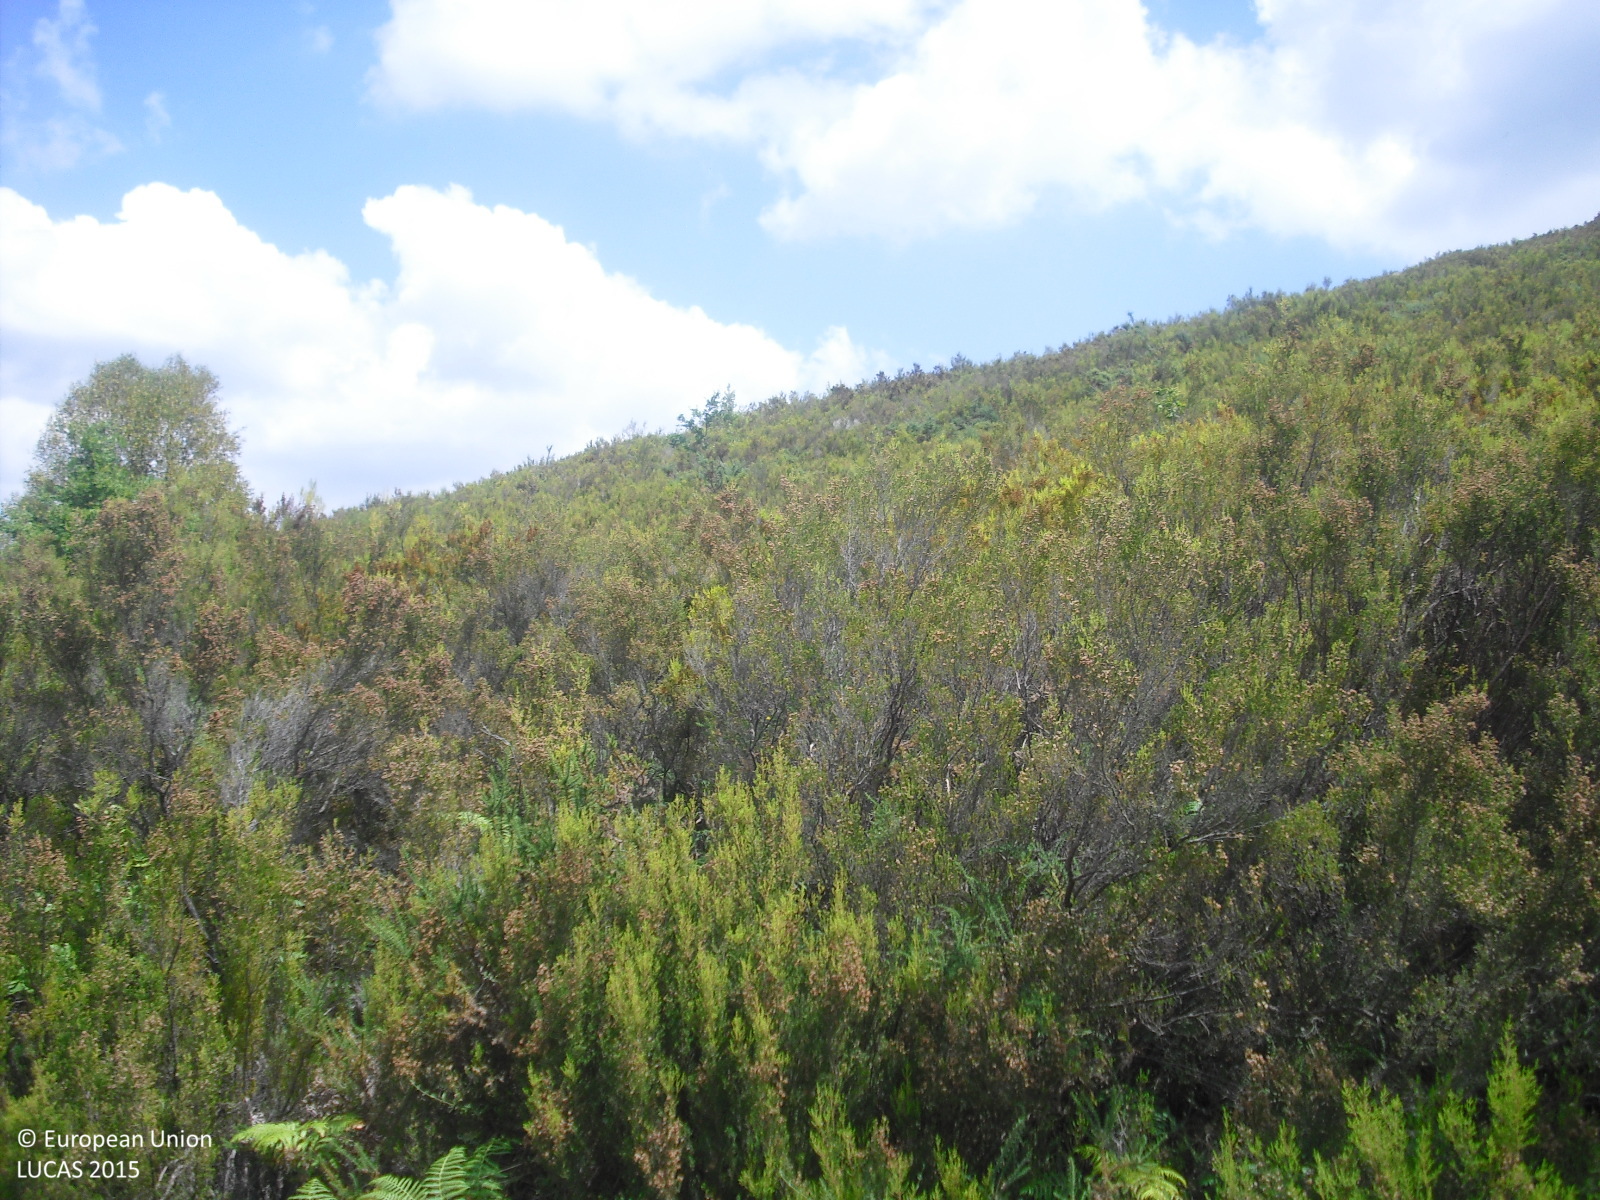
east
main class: Shrubland
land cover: Shrubland without tree cover
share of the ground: > 75 %
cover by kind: shrubs 100 %
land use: Semi-natural and natural areas not in use
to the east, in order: Shrubland without tree cover
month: July
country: ES
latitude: 42.3944
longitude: -7.6751
